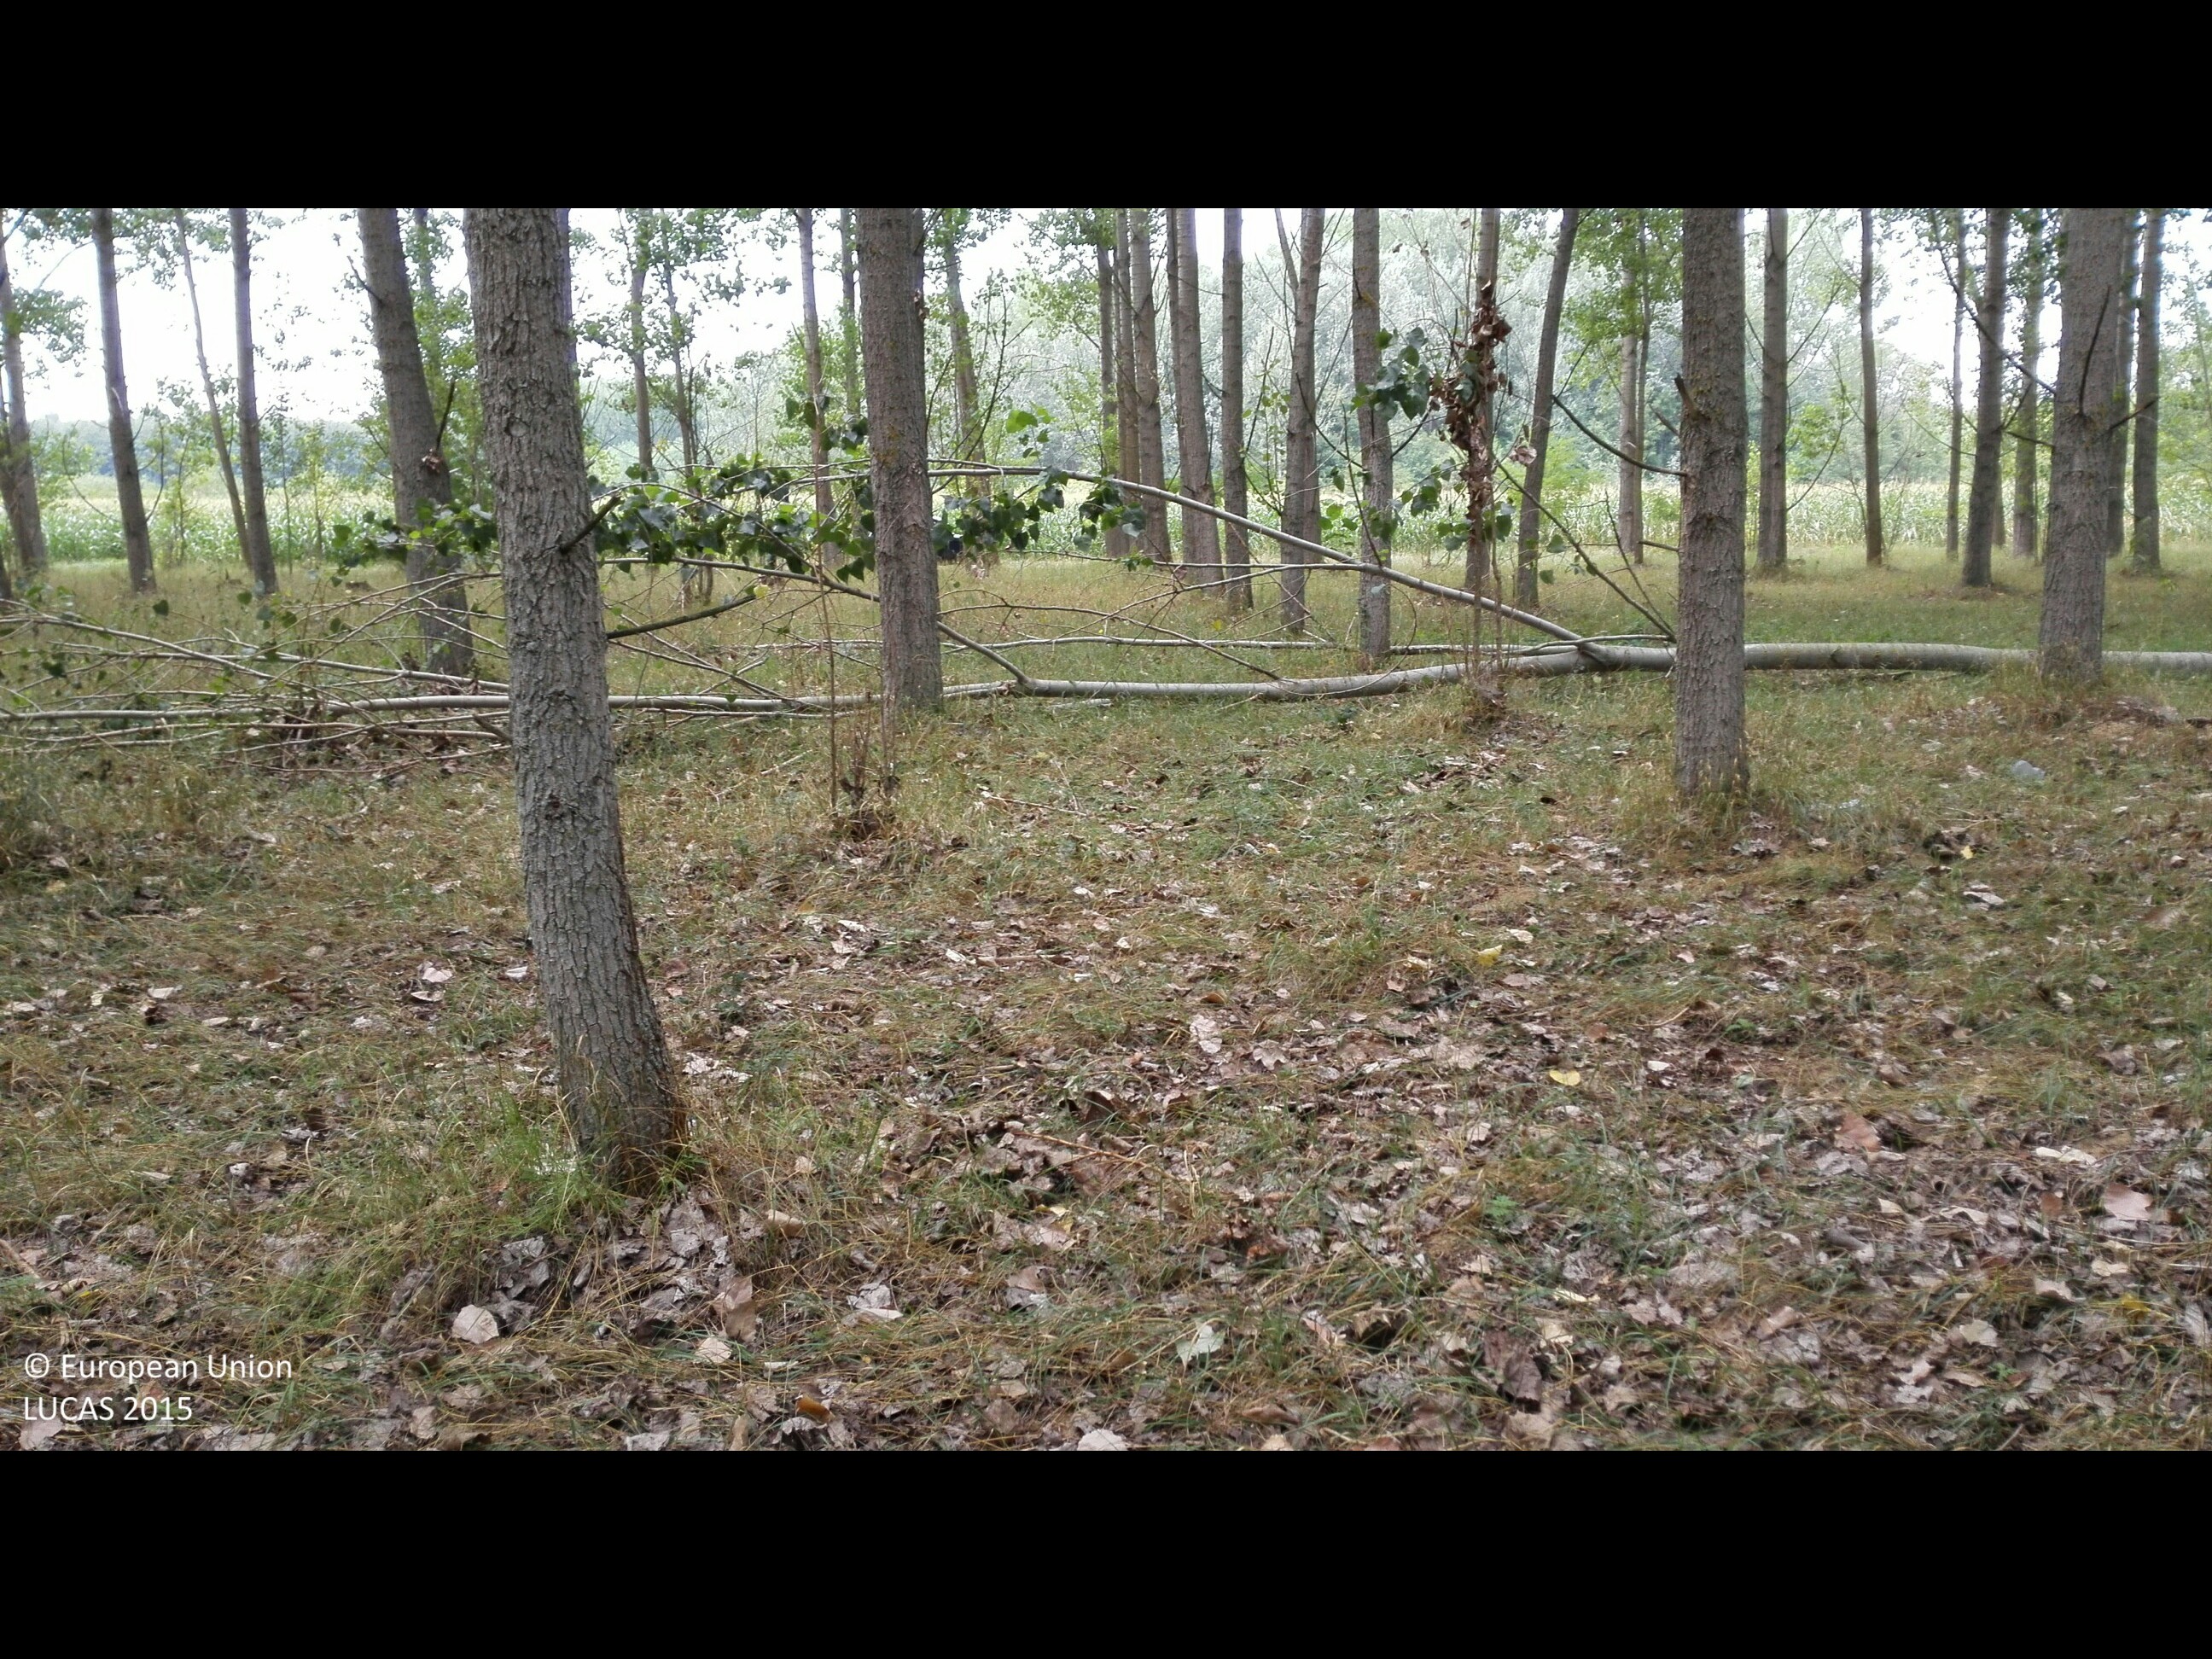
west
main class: Woodland
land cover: Broadleaved woodland
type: non-riverine alder, birch or aspen forest
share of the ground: > 75 %
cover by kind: broadleaved forest trees 90 %, herbaceous plants 10 %
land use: Forestry
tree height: > 5 m
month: August
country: HU
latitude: 47.5415
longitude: 21.8857
